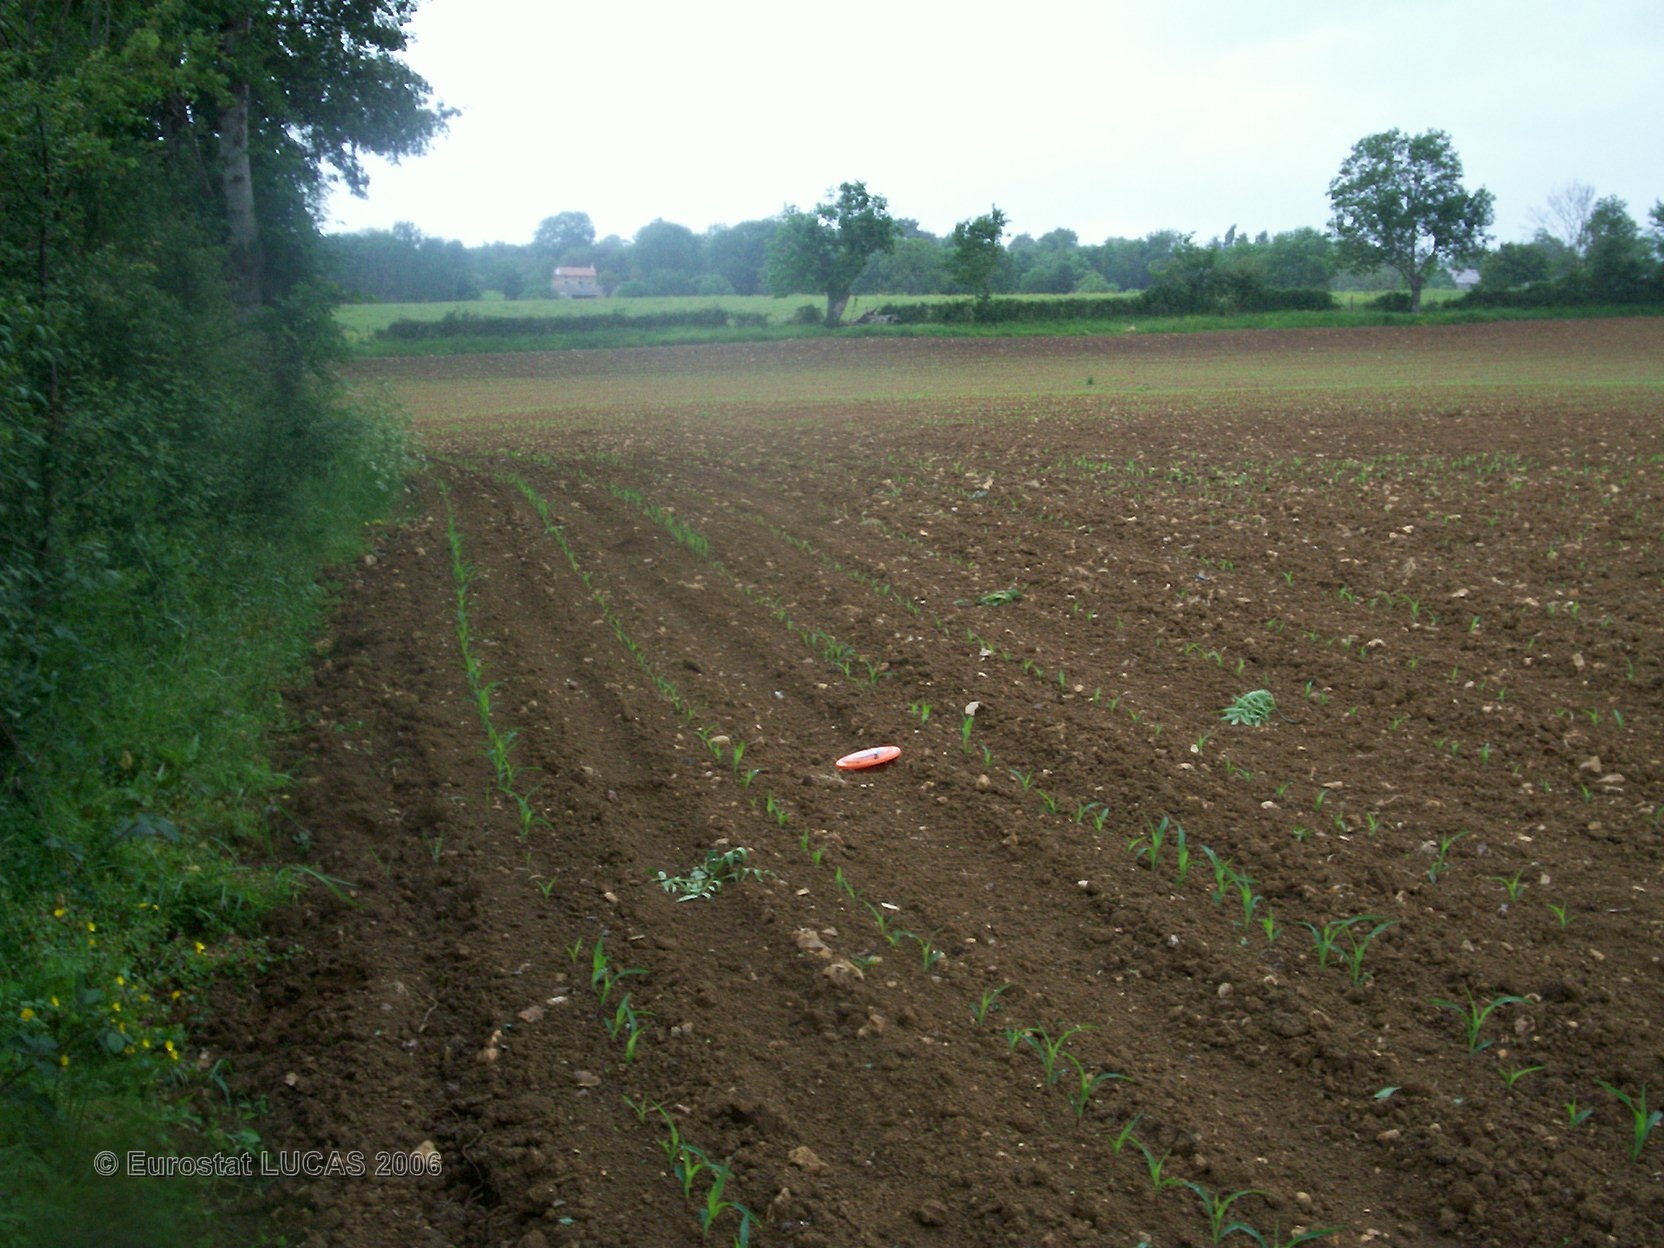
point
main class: Cropland
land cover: Maize
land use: Agriculture (excluding fallow land and kitchen gardens)
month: May
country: FR
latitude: 46.4748
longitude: -0.2479
